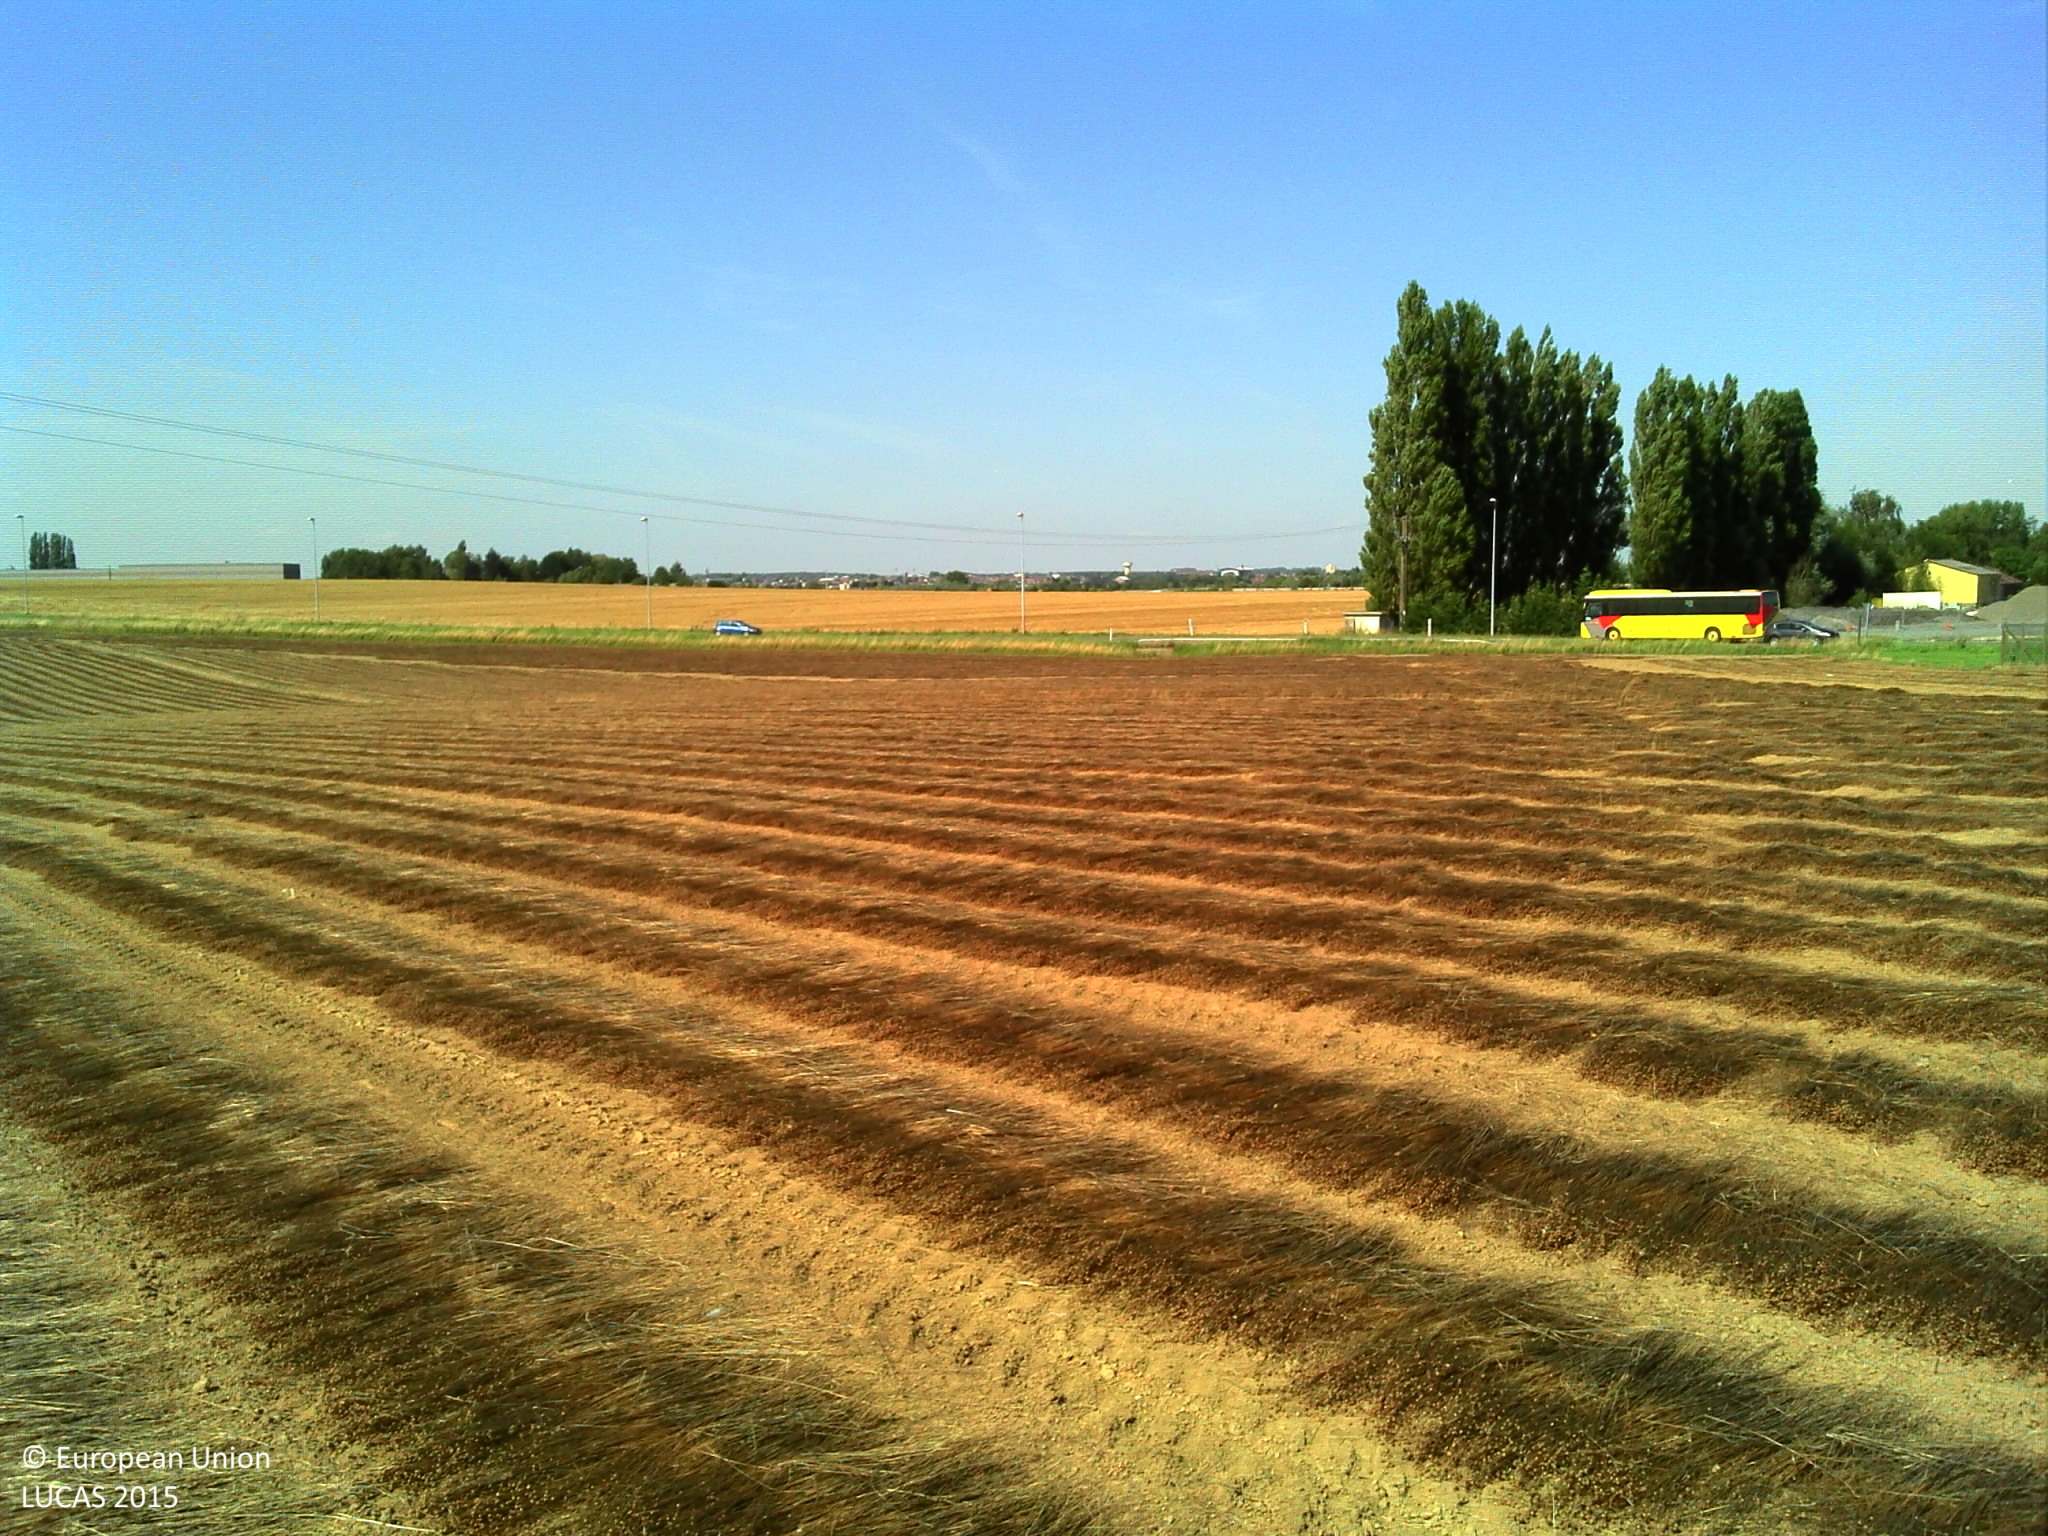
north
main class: Cropland
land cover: Other fibre and oleaginous crops
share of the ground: 10 - 25 %
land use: Agriculture (excluding fallow land and kitchen gardens)
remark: Harvested field
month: August
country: FR
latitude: 50.2400
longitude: 3.9510
